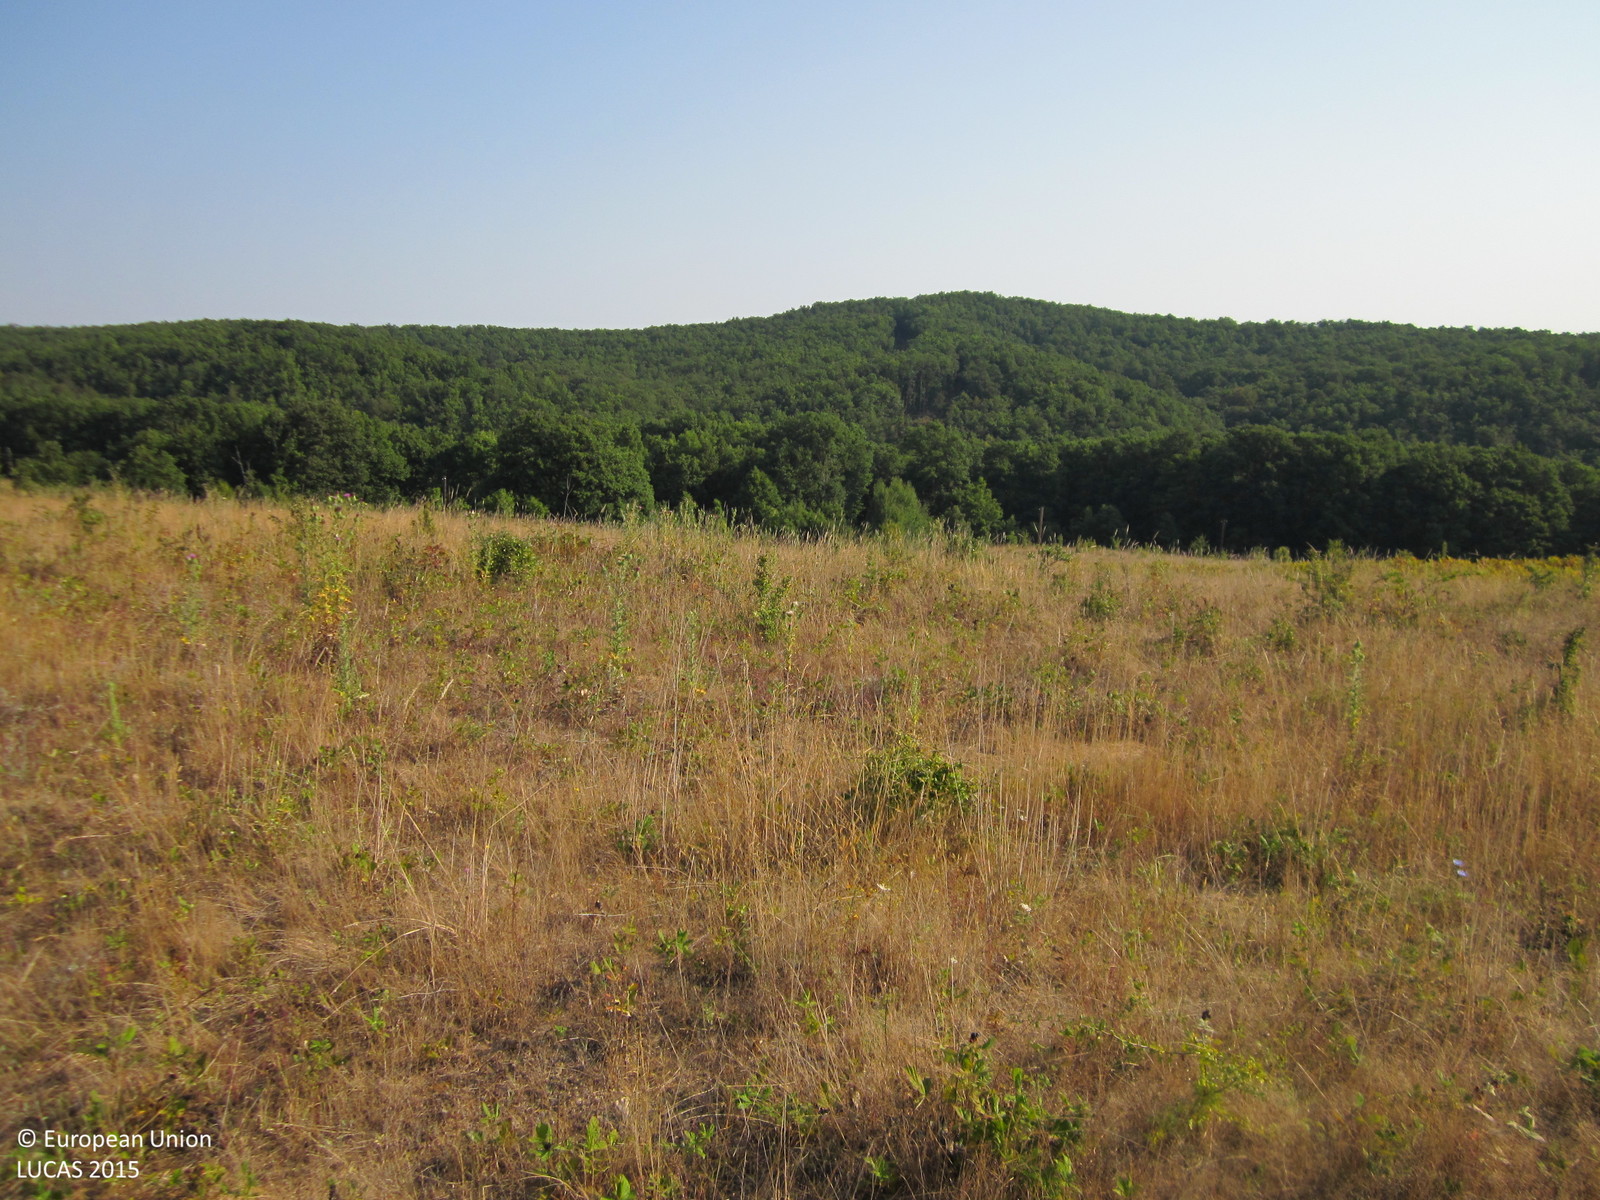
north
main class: Grassland
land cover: Grassland without tree/shrub cover
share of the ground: > 75 %
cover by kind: herbaceous plants 95 %, shrubs 5 %
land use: Agriculture (excluding fallow land and kitchen gardens)
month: August
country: BG
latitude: 41.9707
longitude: 27.6728
